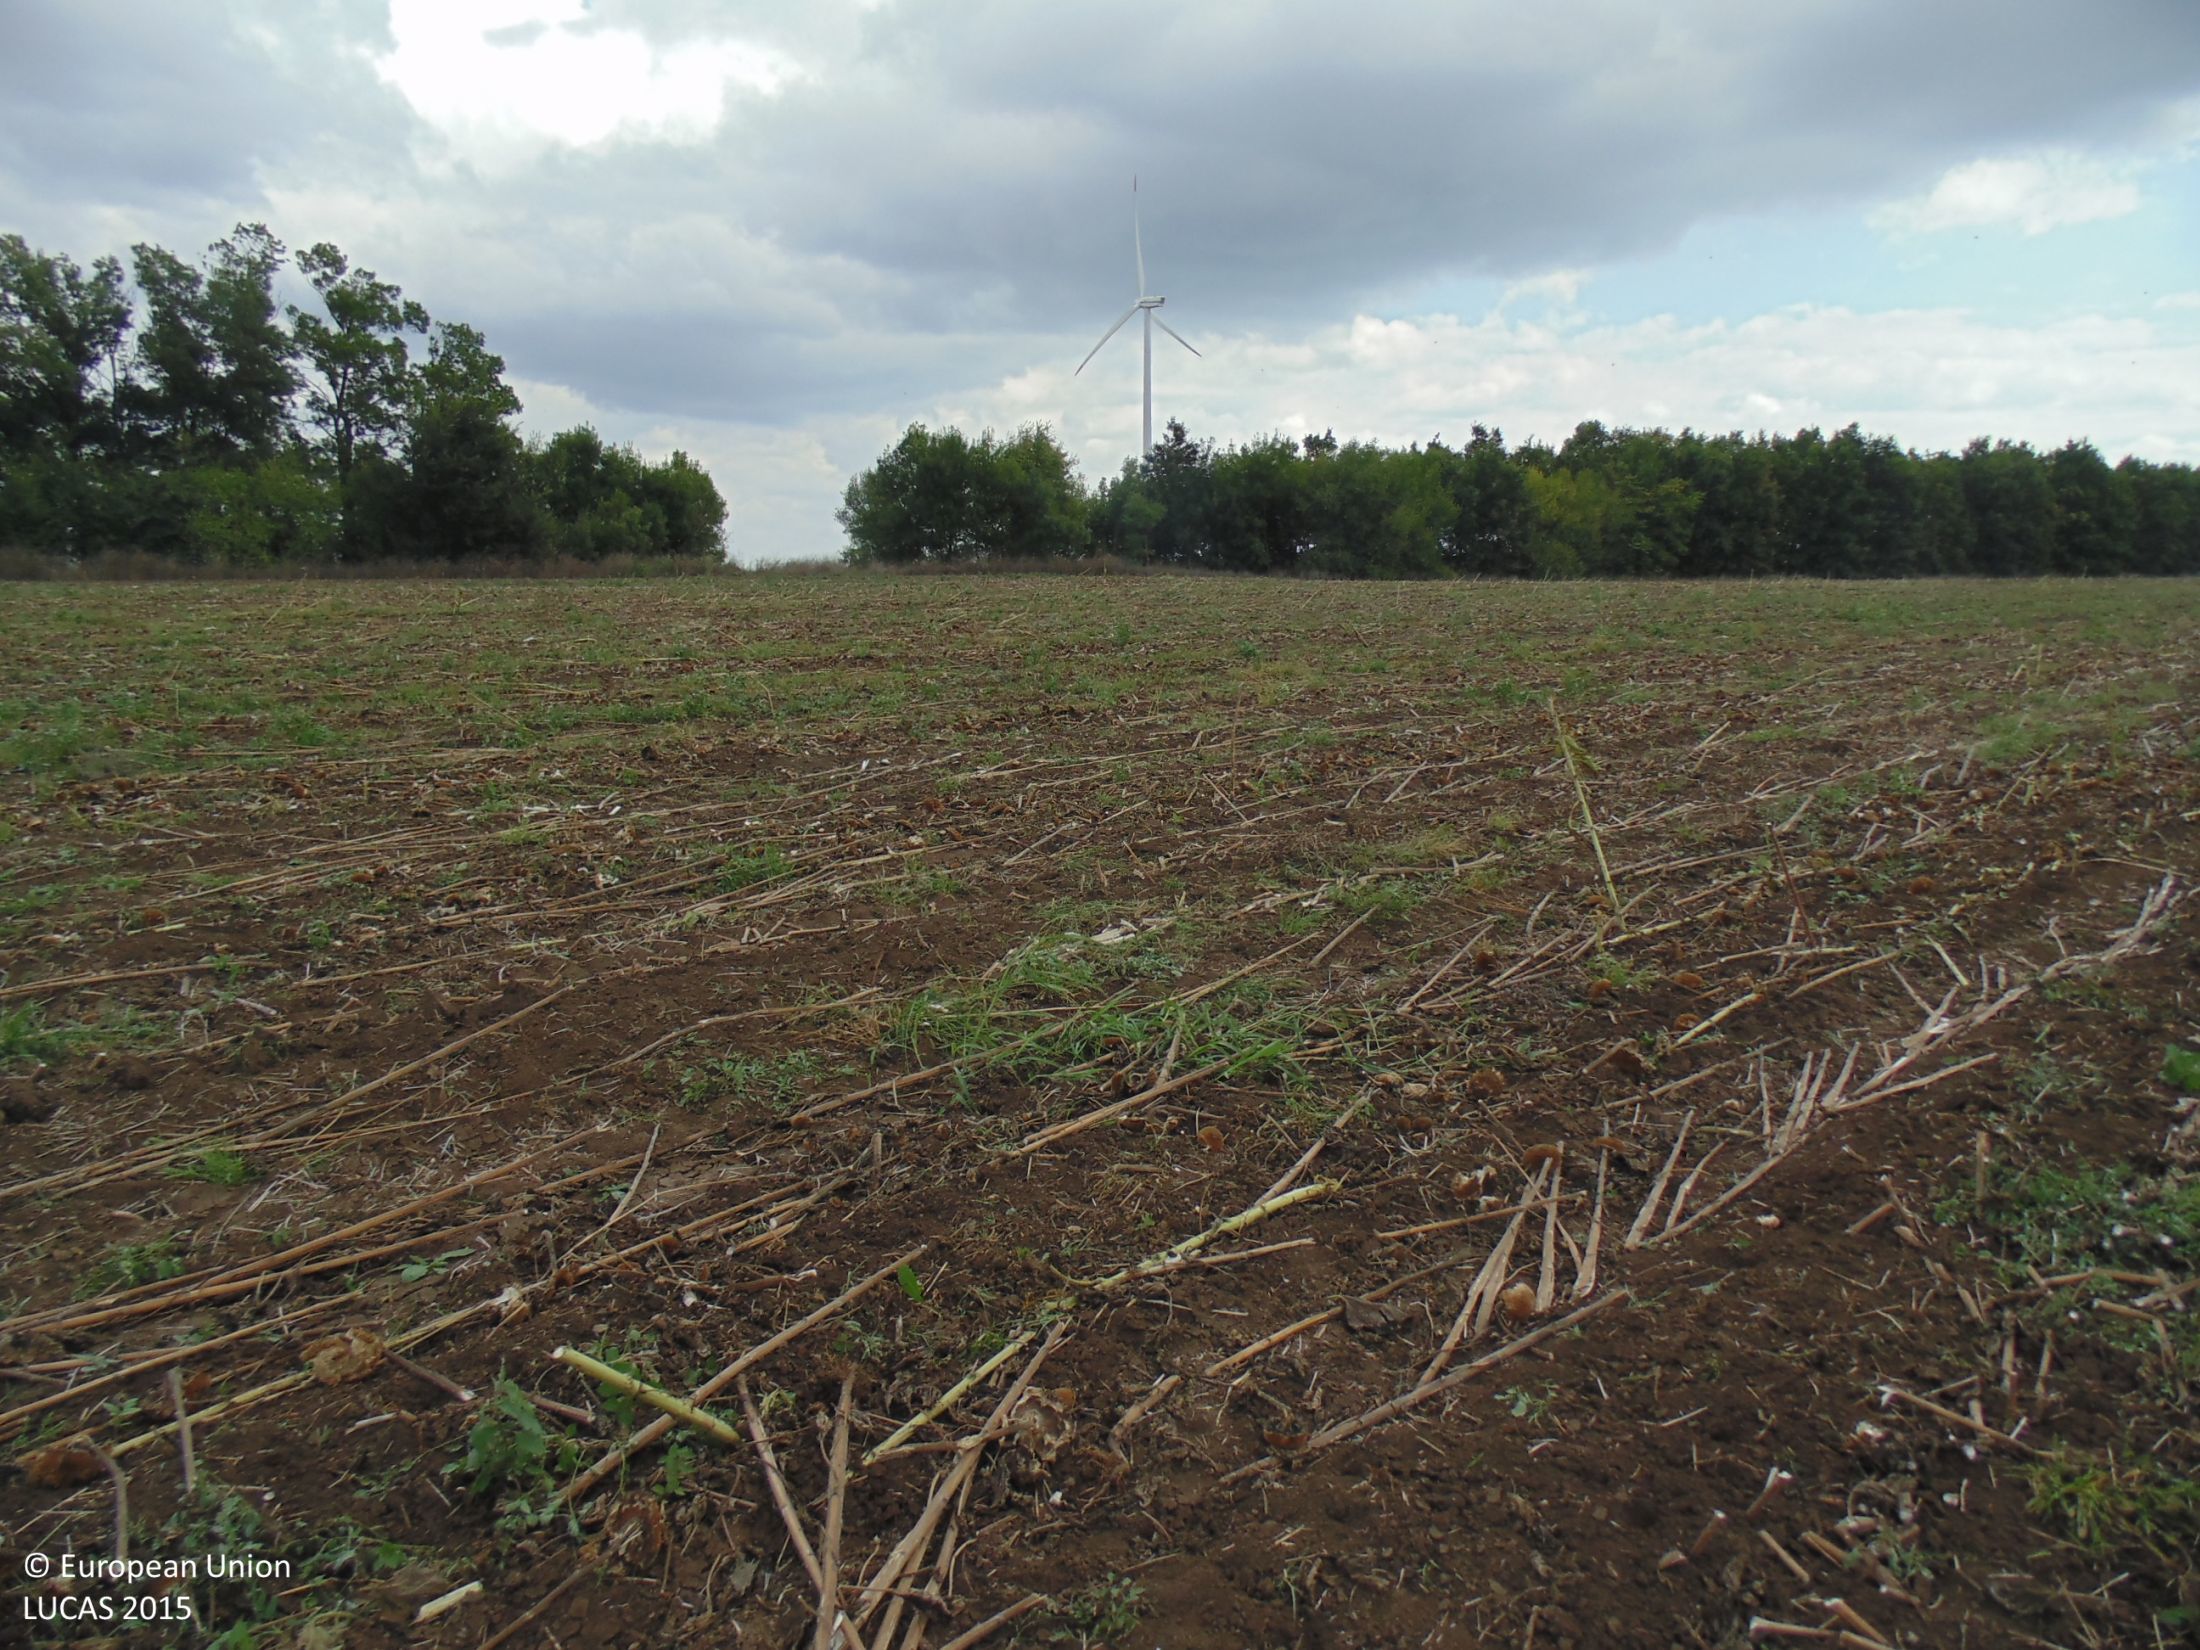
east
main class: Cropland
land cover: Sunflower
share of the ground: < 10 %
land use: Agriculture (excluding fallow land and kitchen gardens)
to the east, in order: Sunflower; Grassland without tree/shrub cover; Broadleaved woodland; Tracks; Grass margins; Common wheat
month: September
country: BG
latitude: 43.4215
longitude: 28.4254
